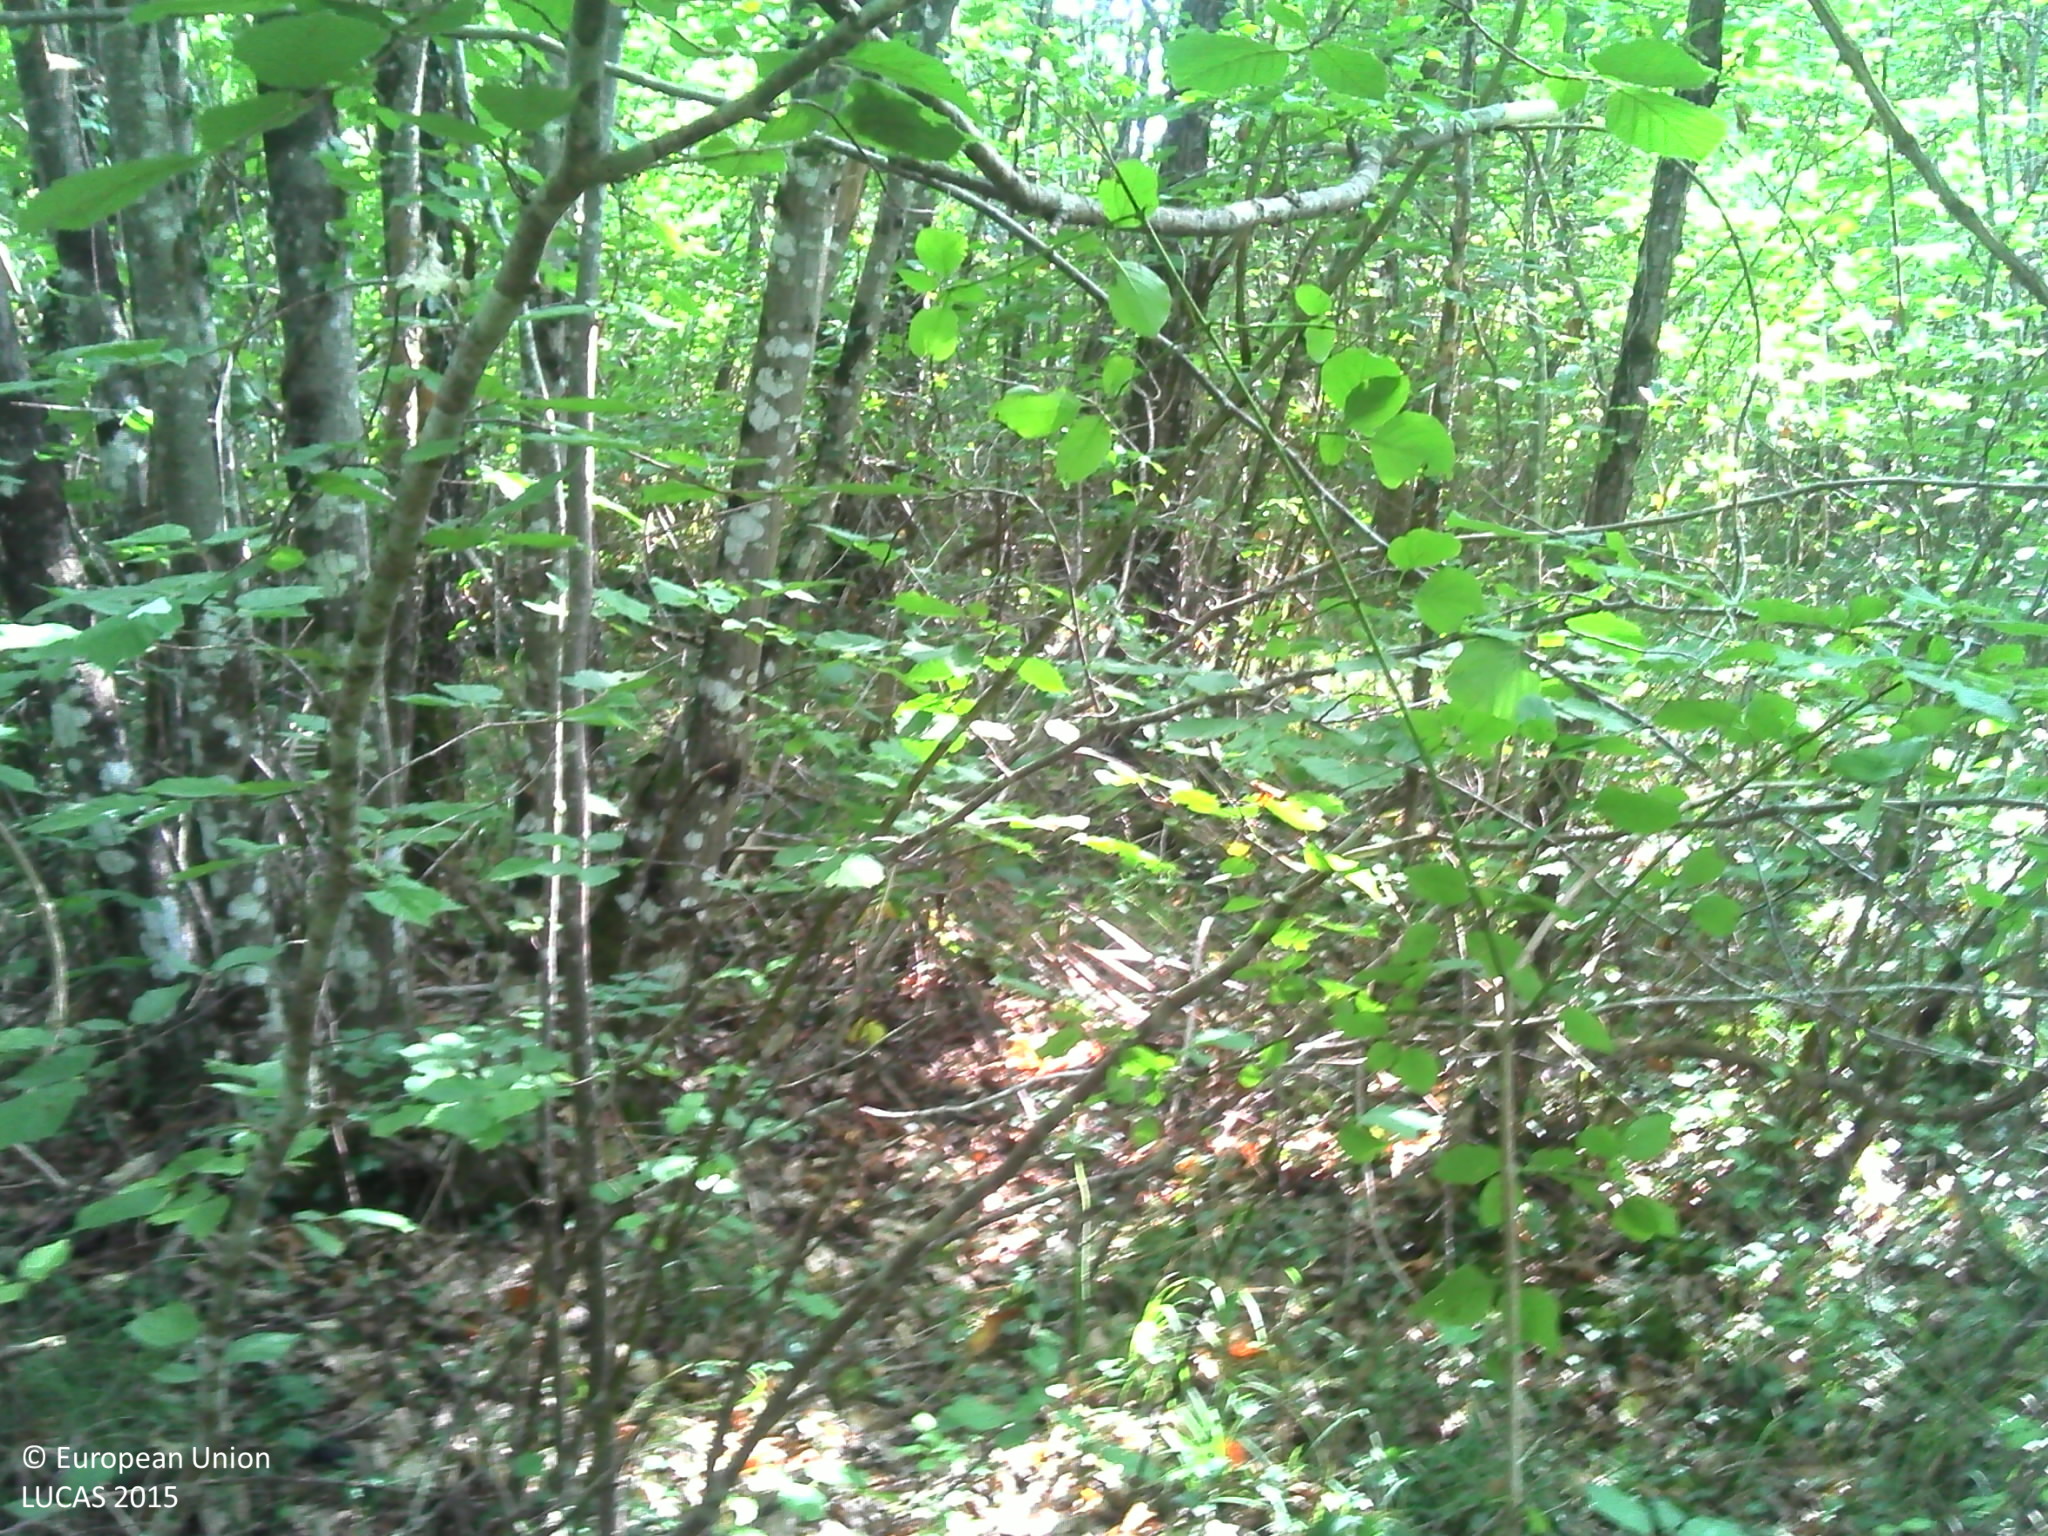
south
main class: Woodland
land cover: Broadleaved woodland
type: mesophytic deciduous forest
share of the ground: > 75 %
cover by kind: broadleaved forest trees 100 %
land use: Semi-natural and natural areas not in use
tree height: > 5 m
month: September
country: FR
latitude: 47.0737
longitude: 1.4139
